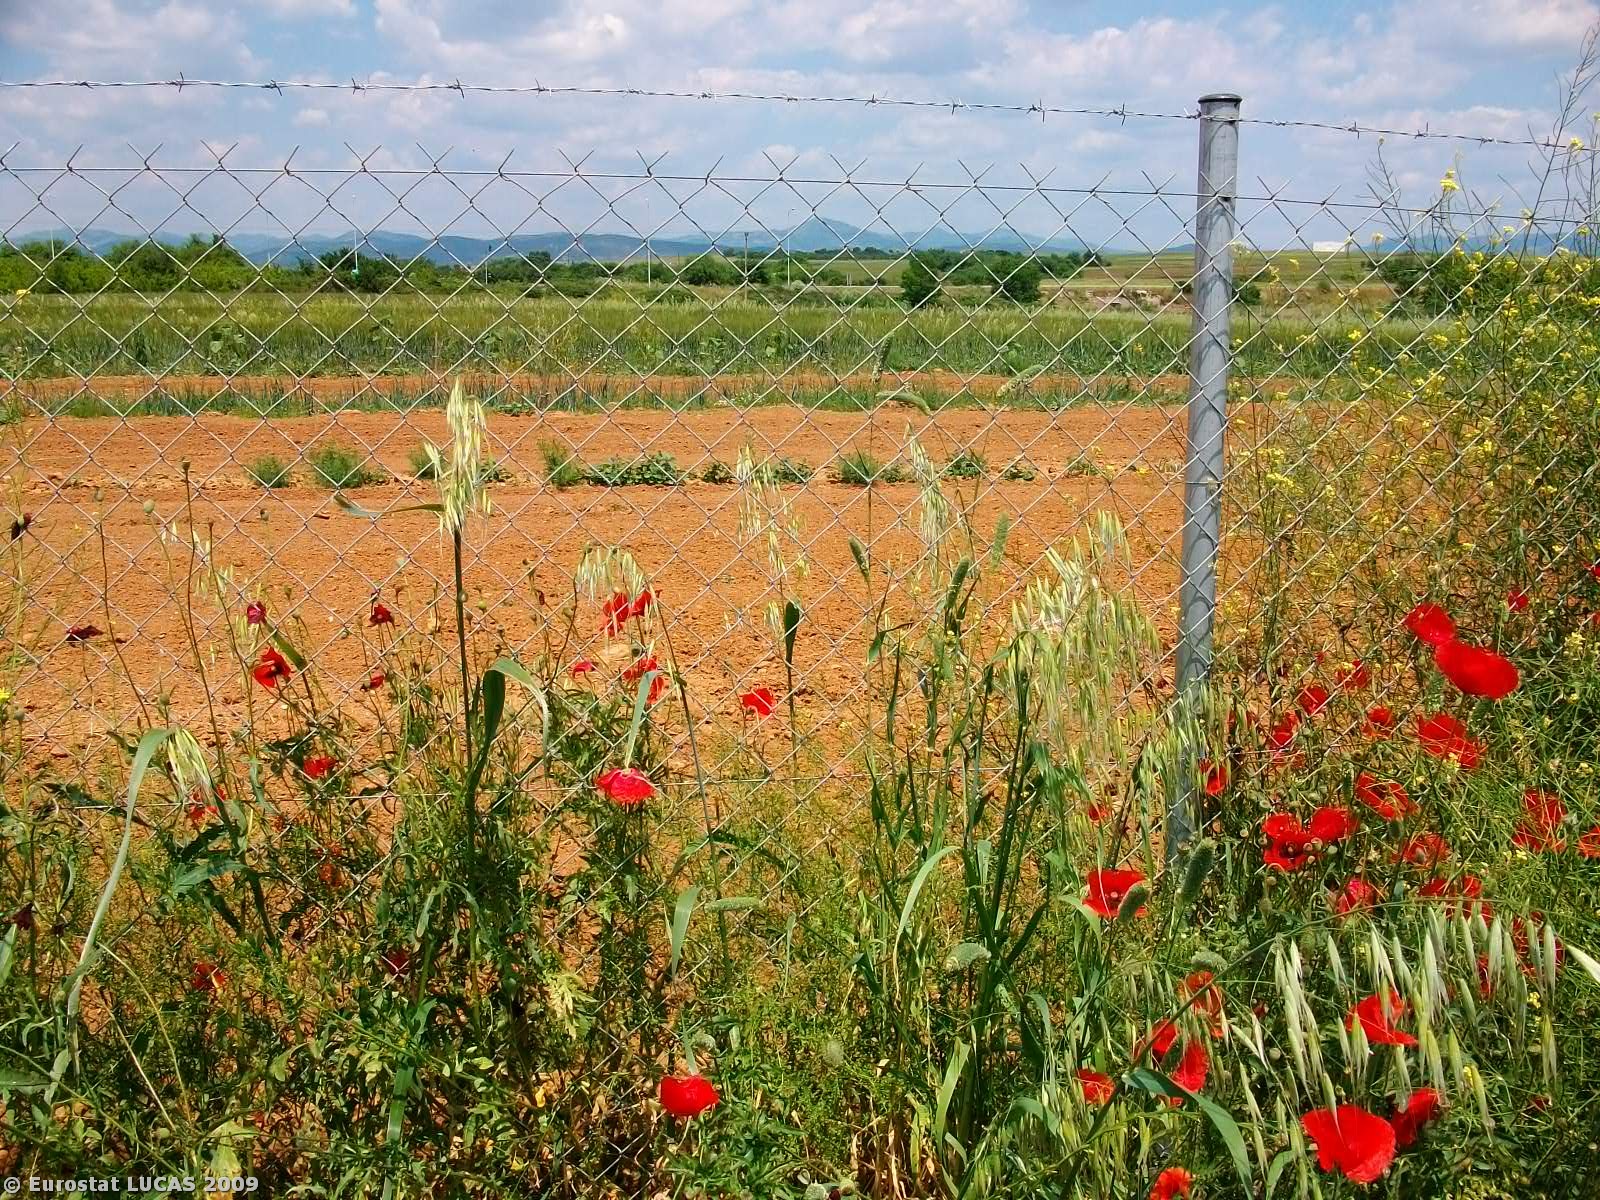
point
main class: Cropland
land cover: Olive groves
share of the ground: < 10 %
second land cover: Bare land
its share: > 75 %
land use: Agriculture (excluding fallow land and kitchen gardens)
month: May
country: GR
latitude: 41.0866
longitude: 25.4914
